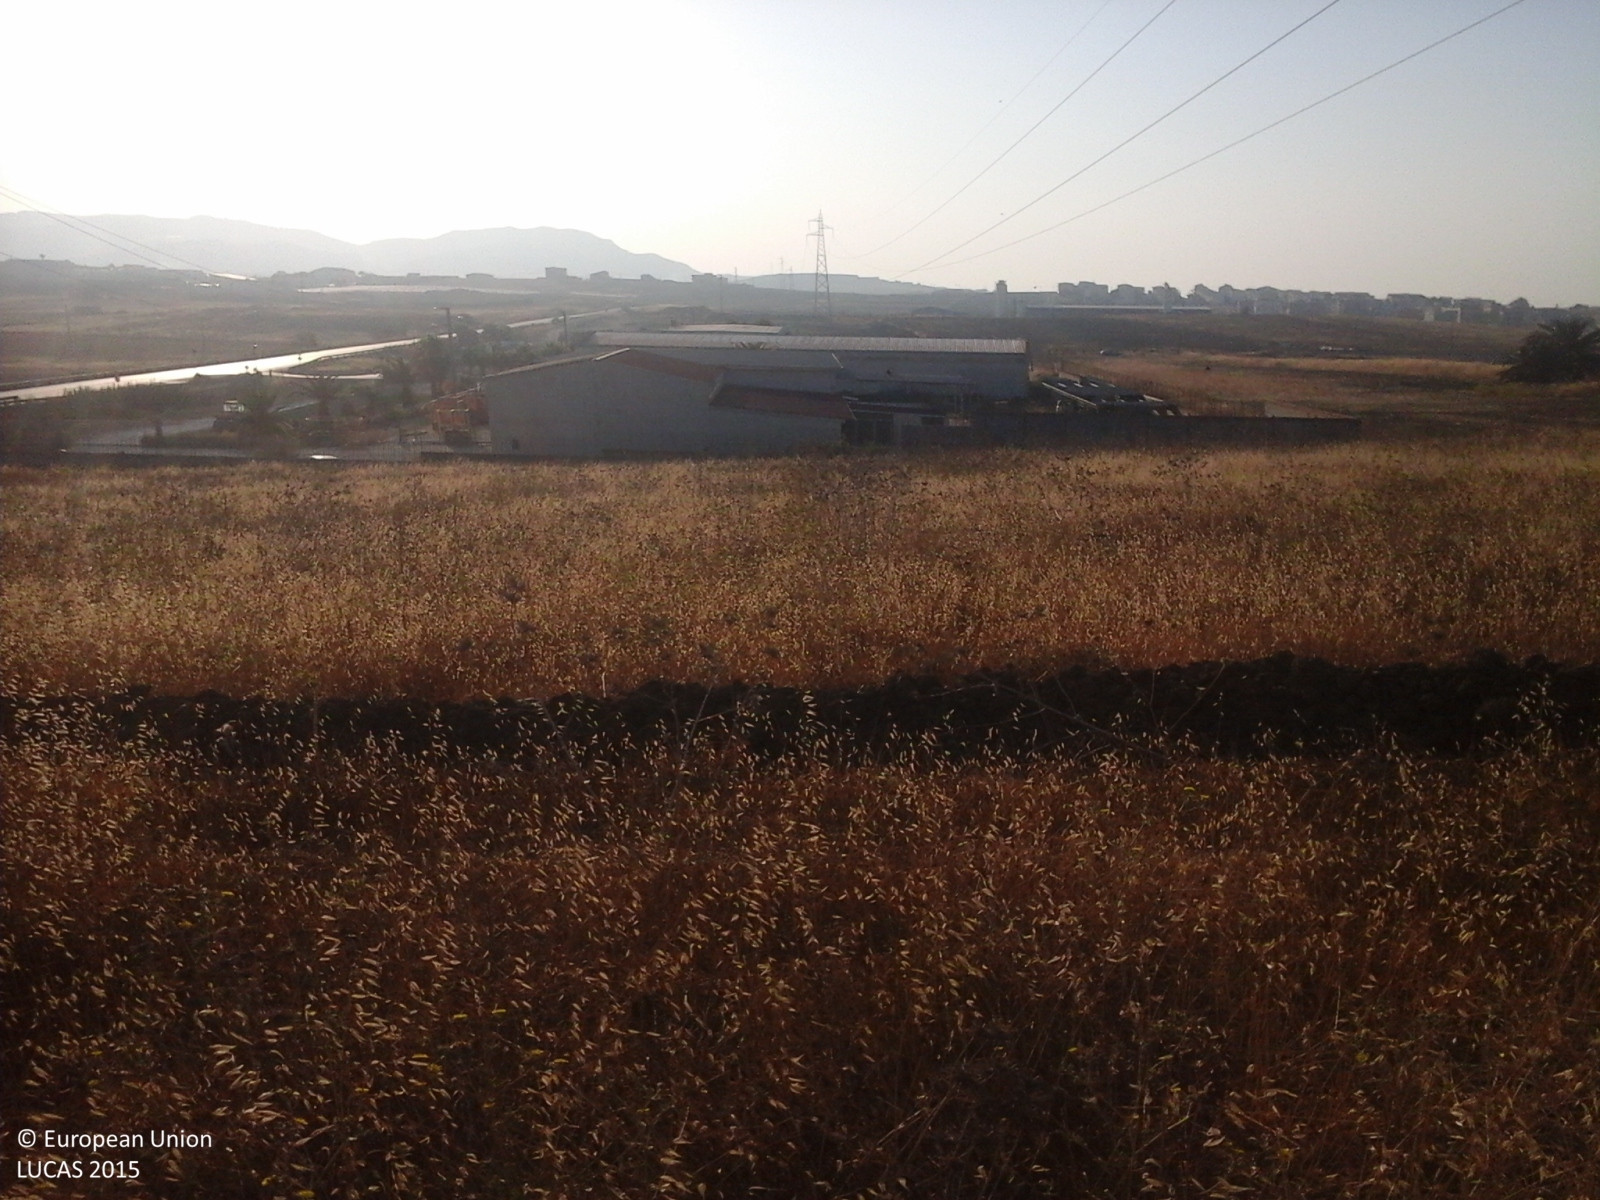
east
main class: Grassland
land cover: Spontaneously vegetated surfaces
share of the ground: > 75 %
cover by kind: herbaceous plants 100 %
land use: Fallow land
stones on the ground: > 50 %
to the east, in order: Spontaneously vegetated surfaces; Artificial constructions in urban areas
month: July
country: IT
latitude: 37.1205
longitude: 13.9417
